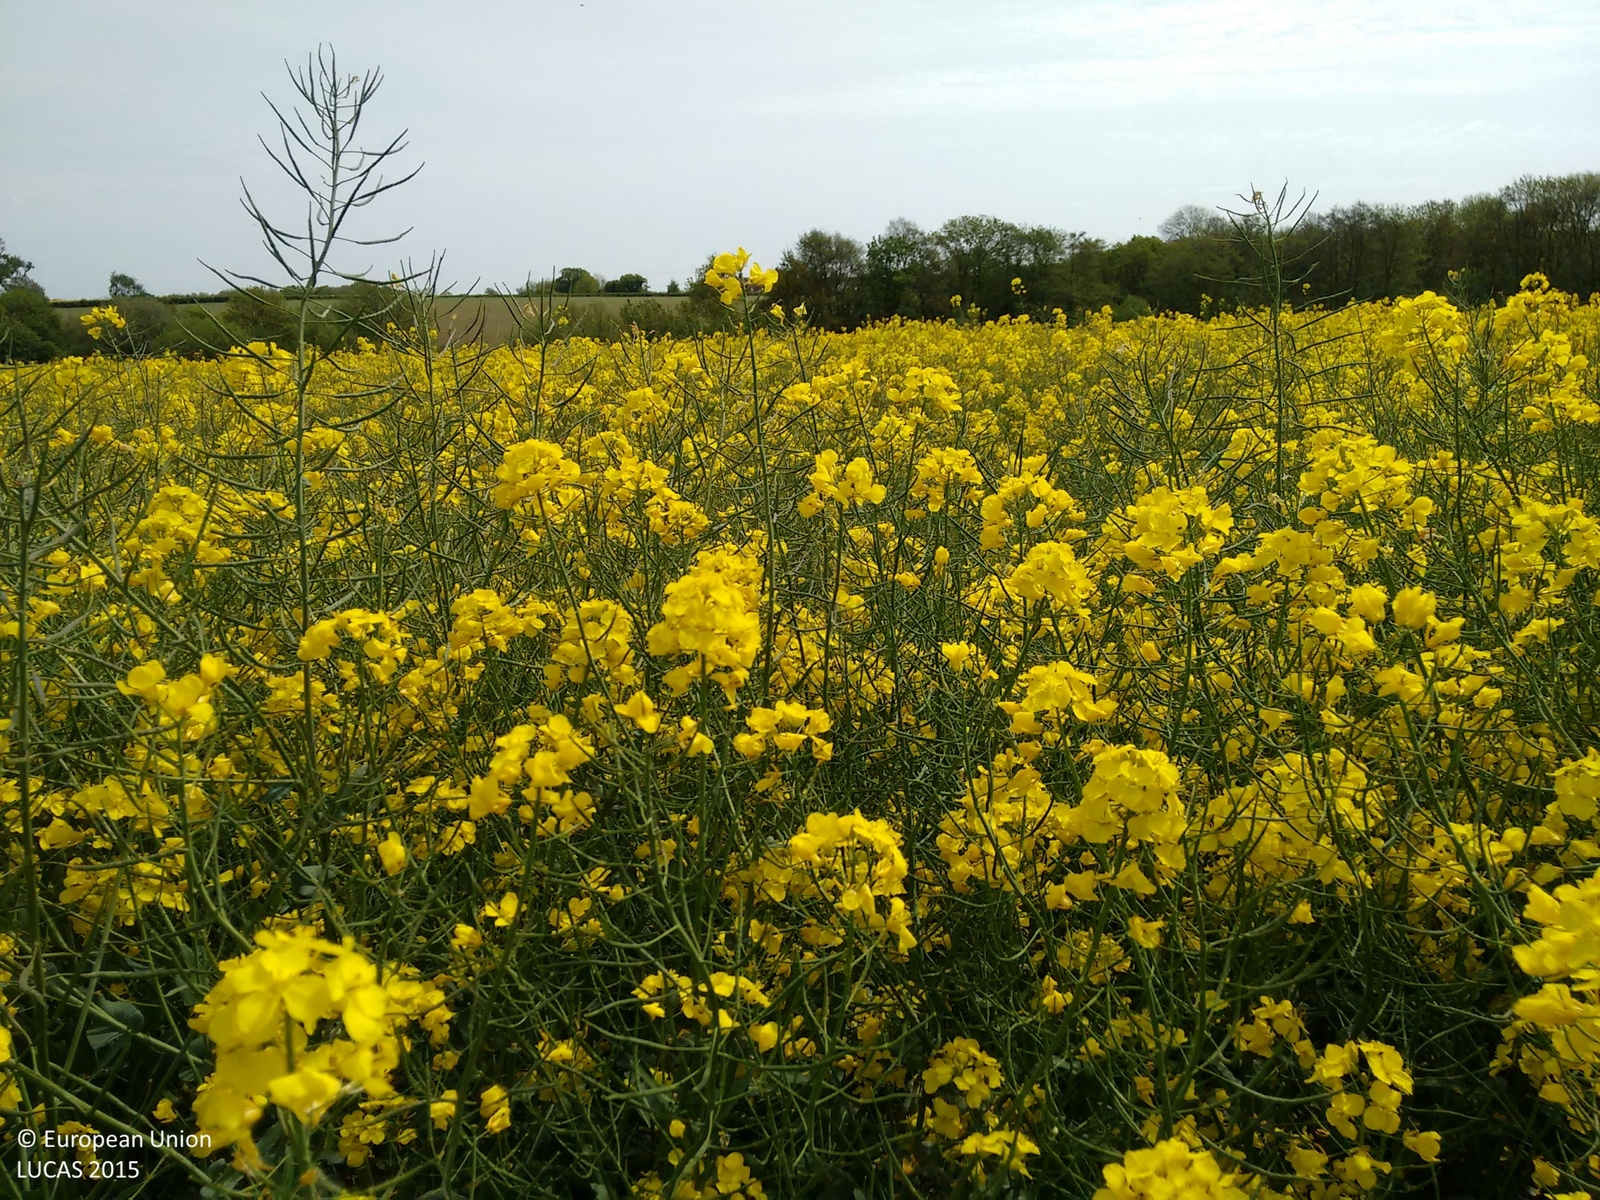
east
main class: Cropland
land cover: Rape and turnip rape
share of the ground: > 75 %
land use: Agriculture (excluding fallow land and kitchen gardens)
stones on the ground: < 10 %
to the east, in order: Rape and turnip rape; Grassland without tree/shrub cover; Tracks; Grassland without tree/shrub cover; Abandoned hedges; Inland fresh running water; Abandoned hedges; Grassland without tree/shrub cover; Common wheat
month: May
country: GB
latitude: 51.1836
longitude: 0.3135
